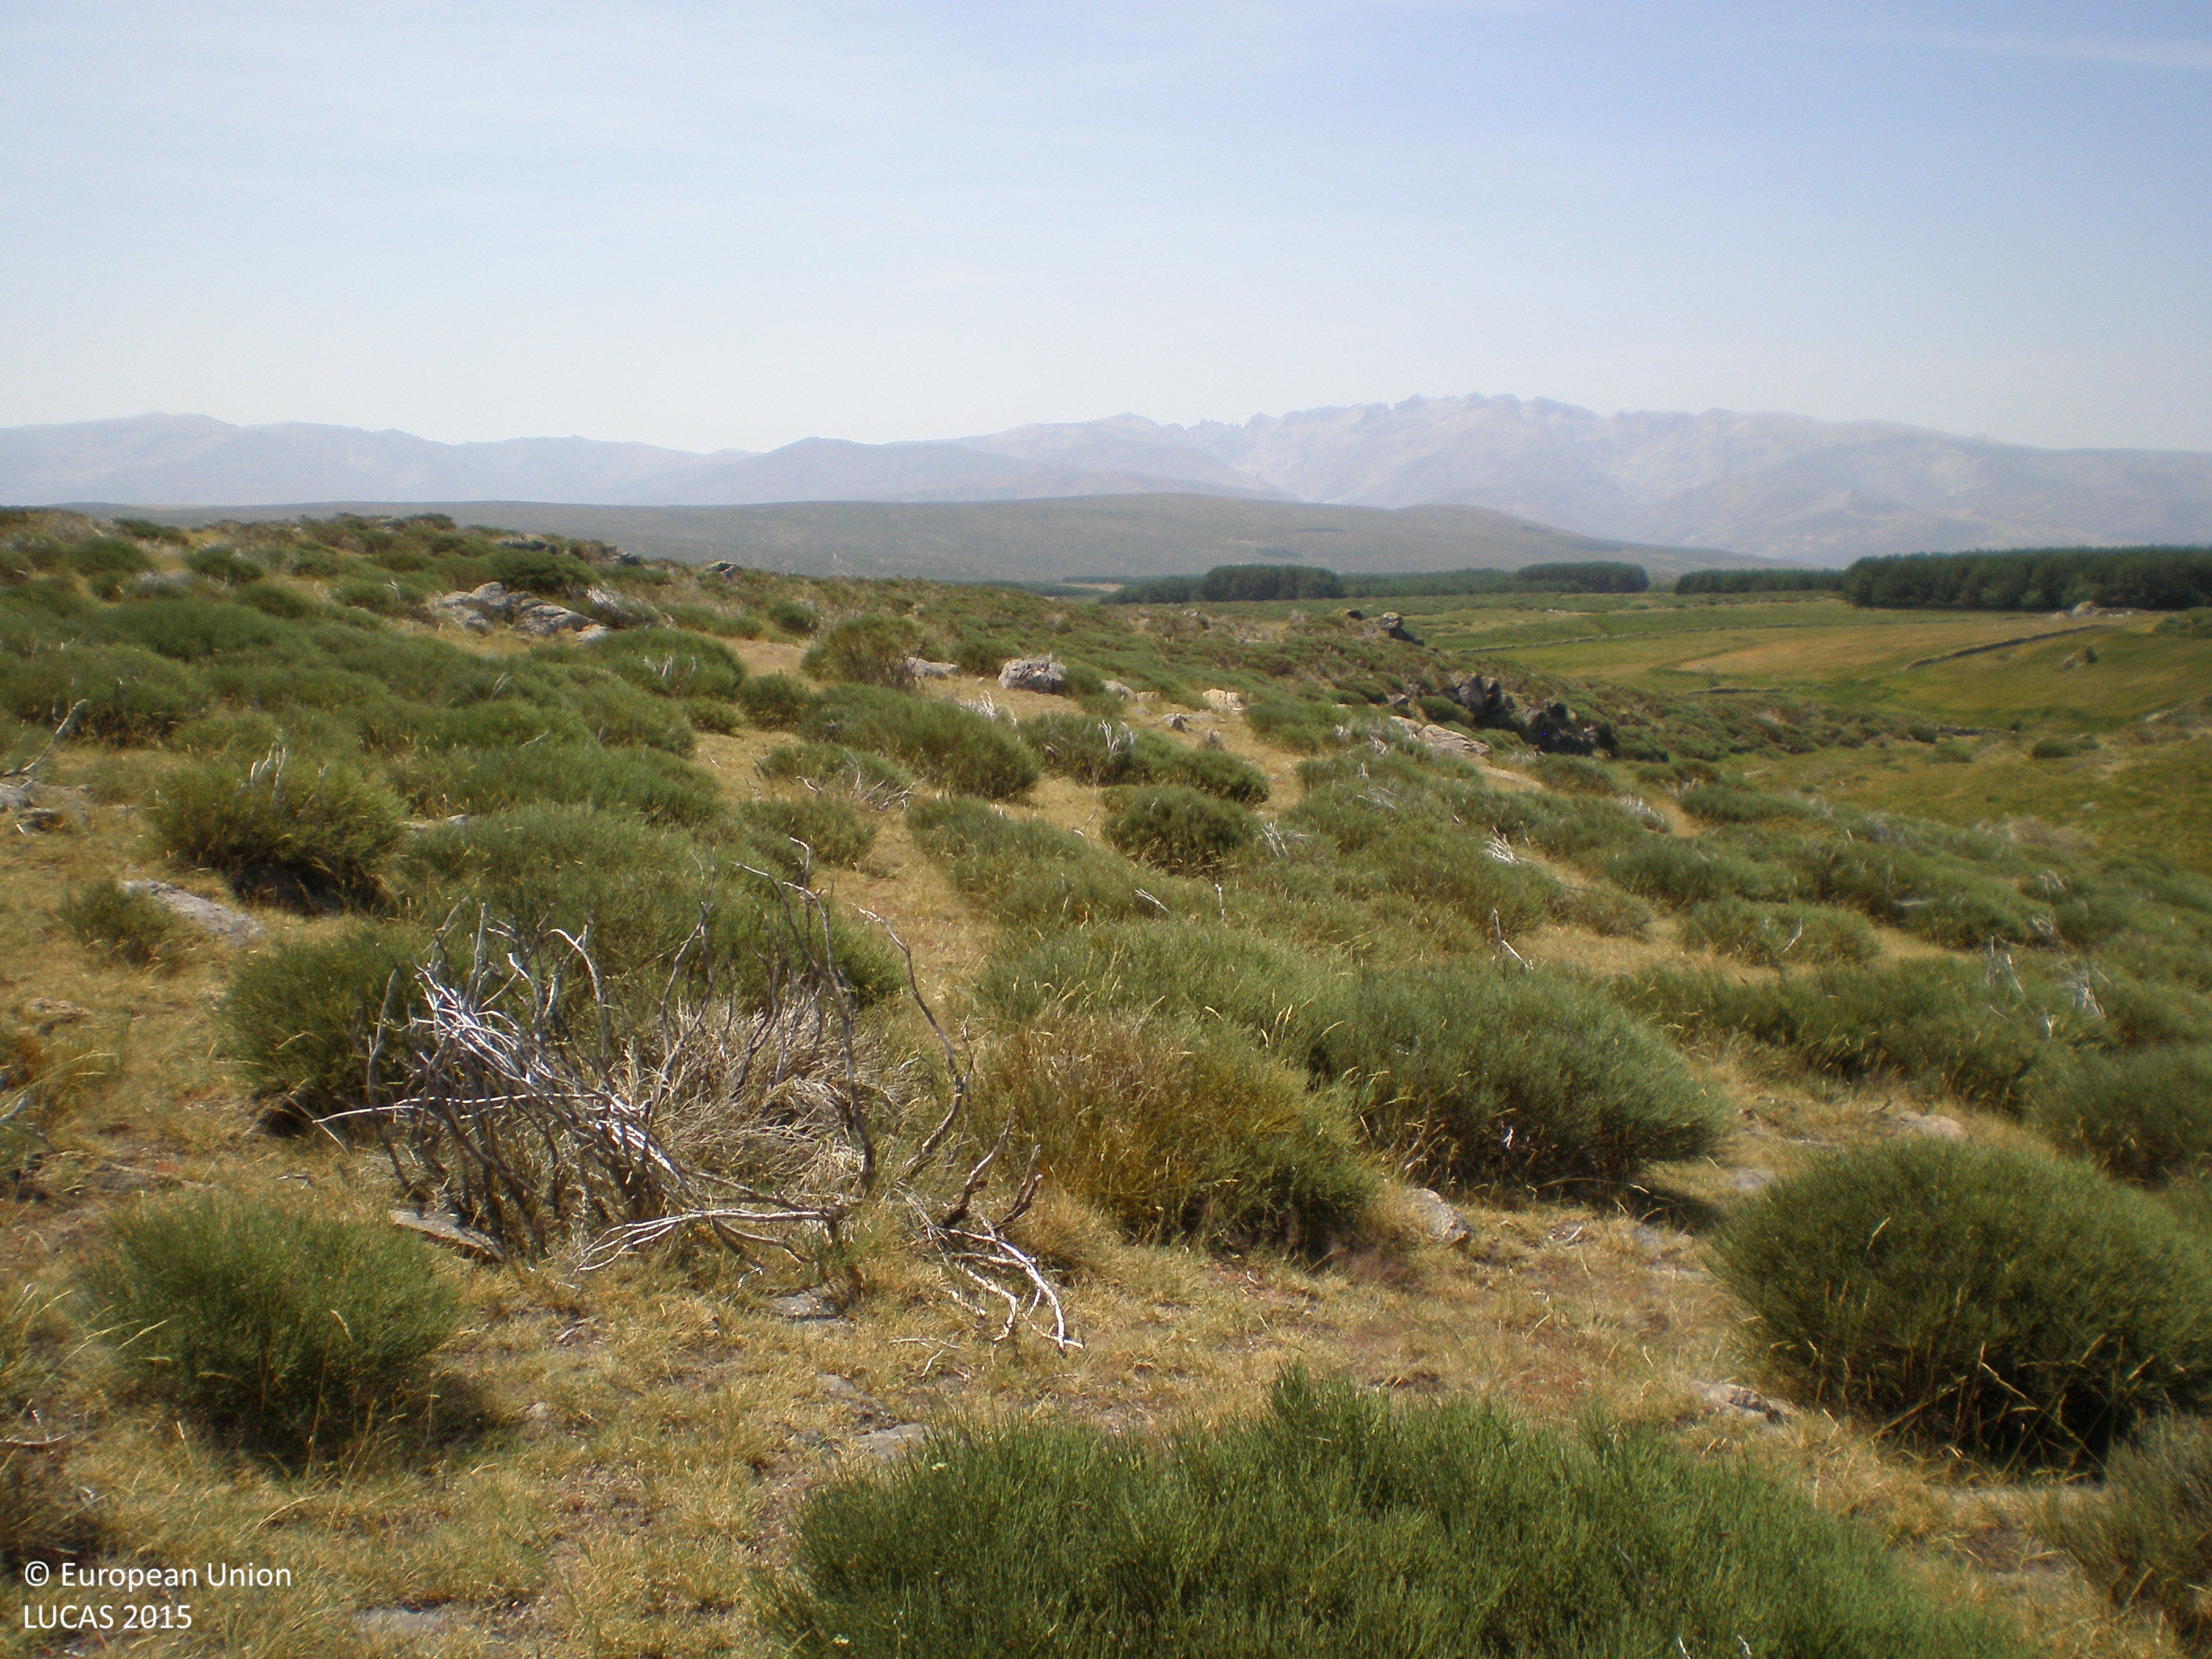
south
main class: Shrubland
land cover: Shrubland without tree cover
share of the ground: > 75 %
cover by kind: shrubs 80 %, herbaceous plants 20 %
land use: Agriculture (excluding fallow land and kitchen gardens)
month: July
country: ES
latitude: 40.4296
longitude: -5.2319
